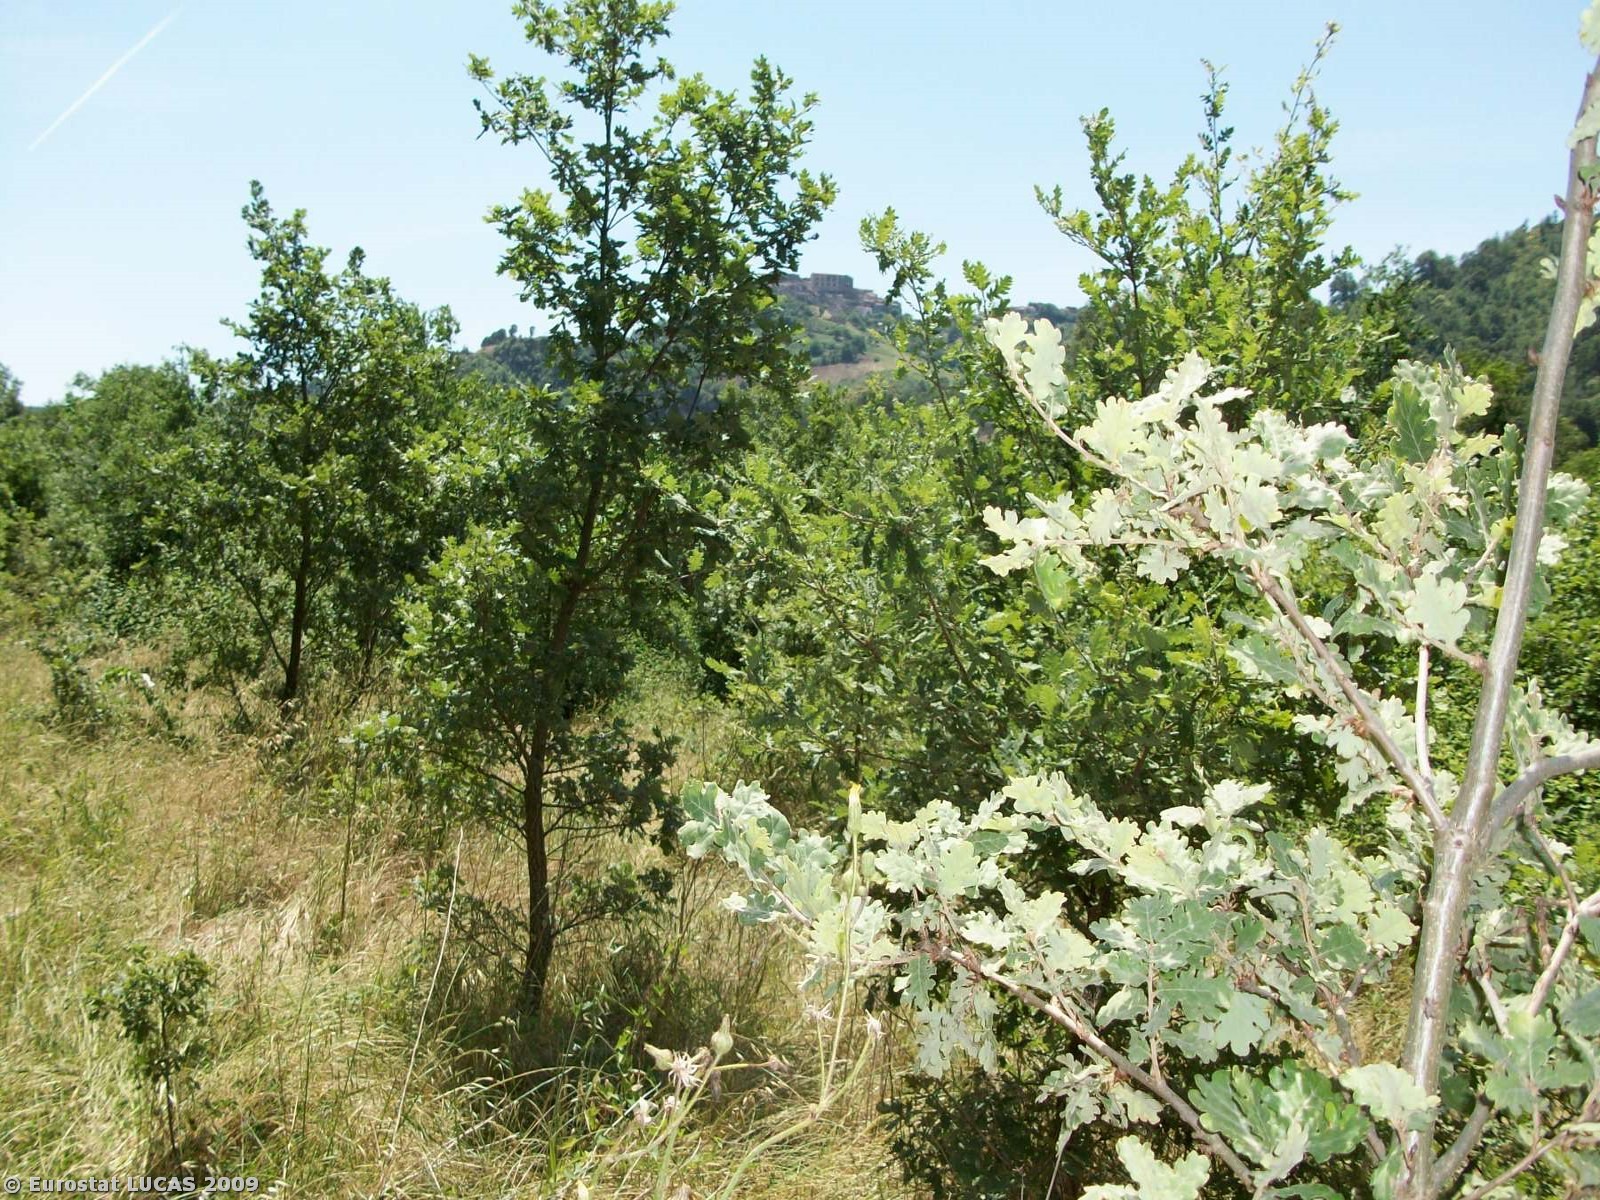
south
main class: Woodland
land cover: Broadleaved woodland
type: thermophilous deciduous forest
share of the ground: > 75 %
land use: Unused
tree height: > 5 m
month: June
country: IT
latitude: 39.6619
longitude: 16.0680
